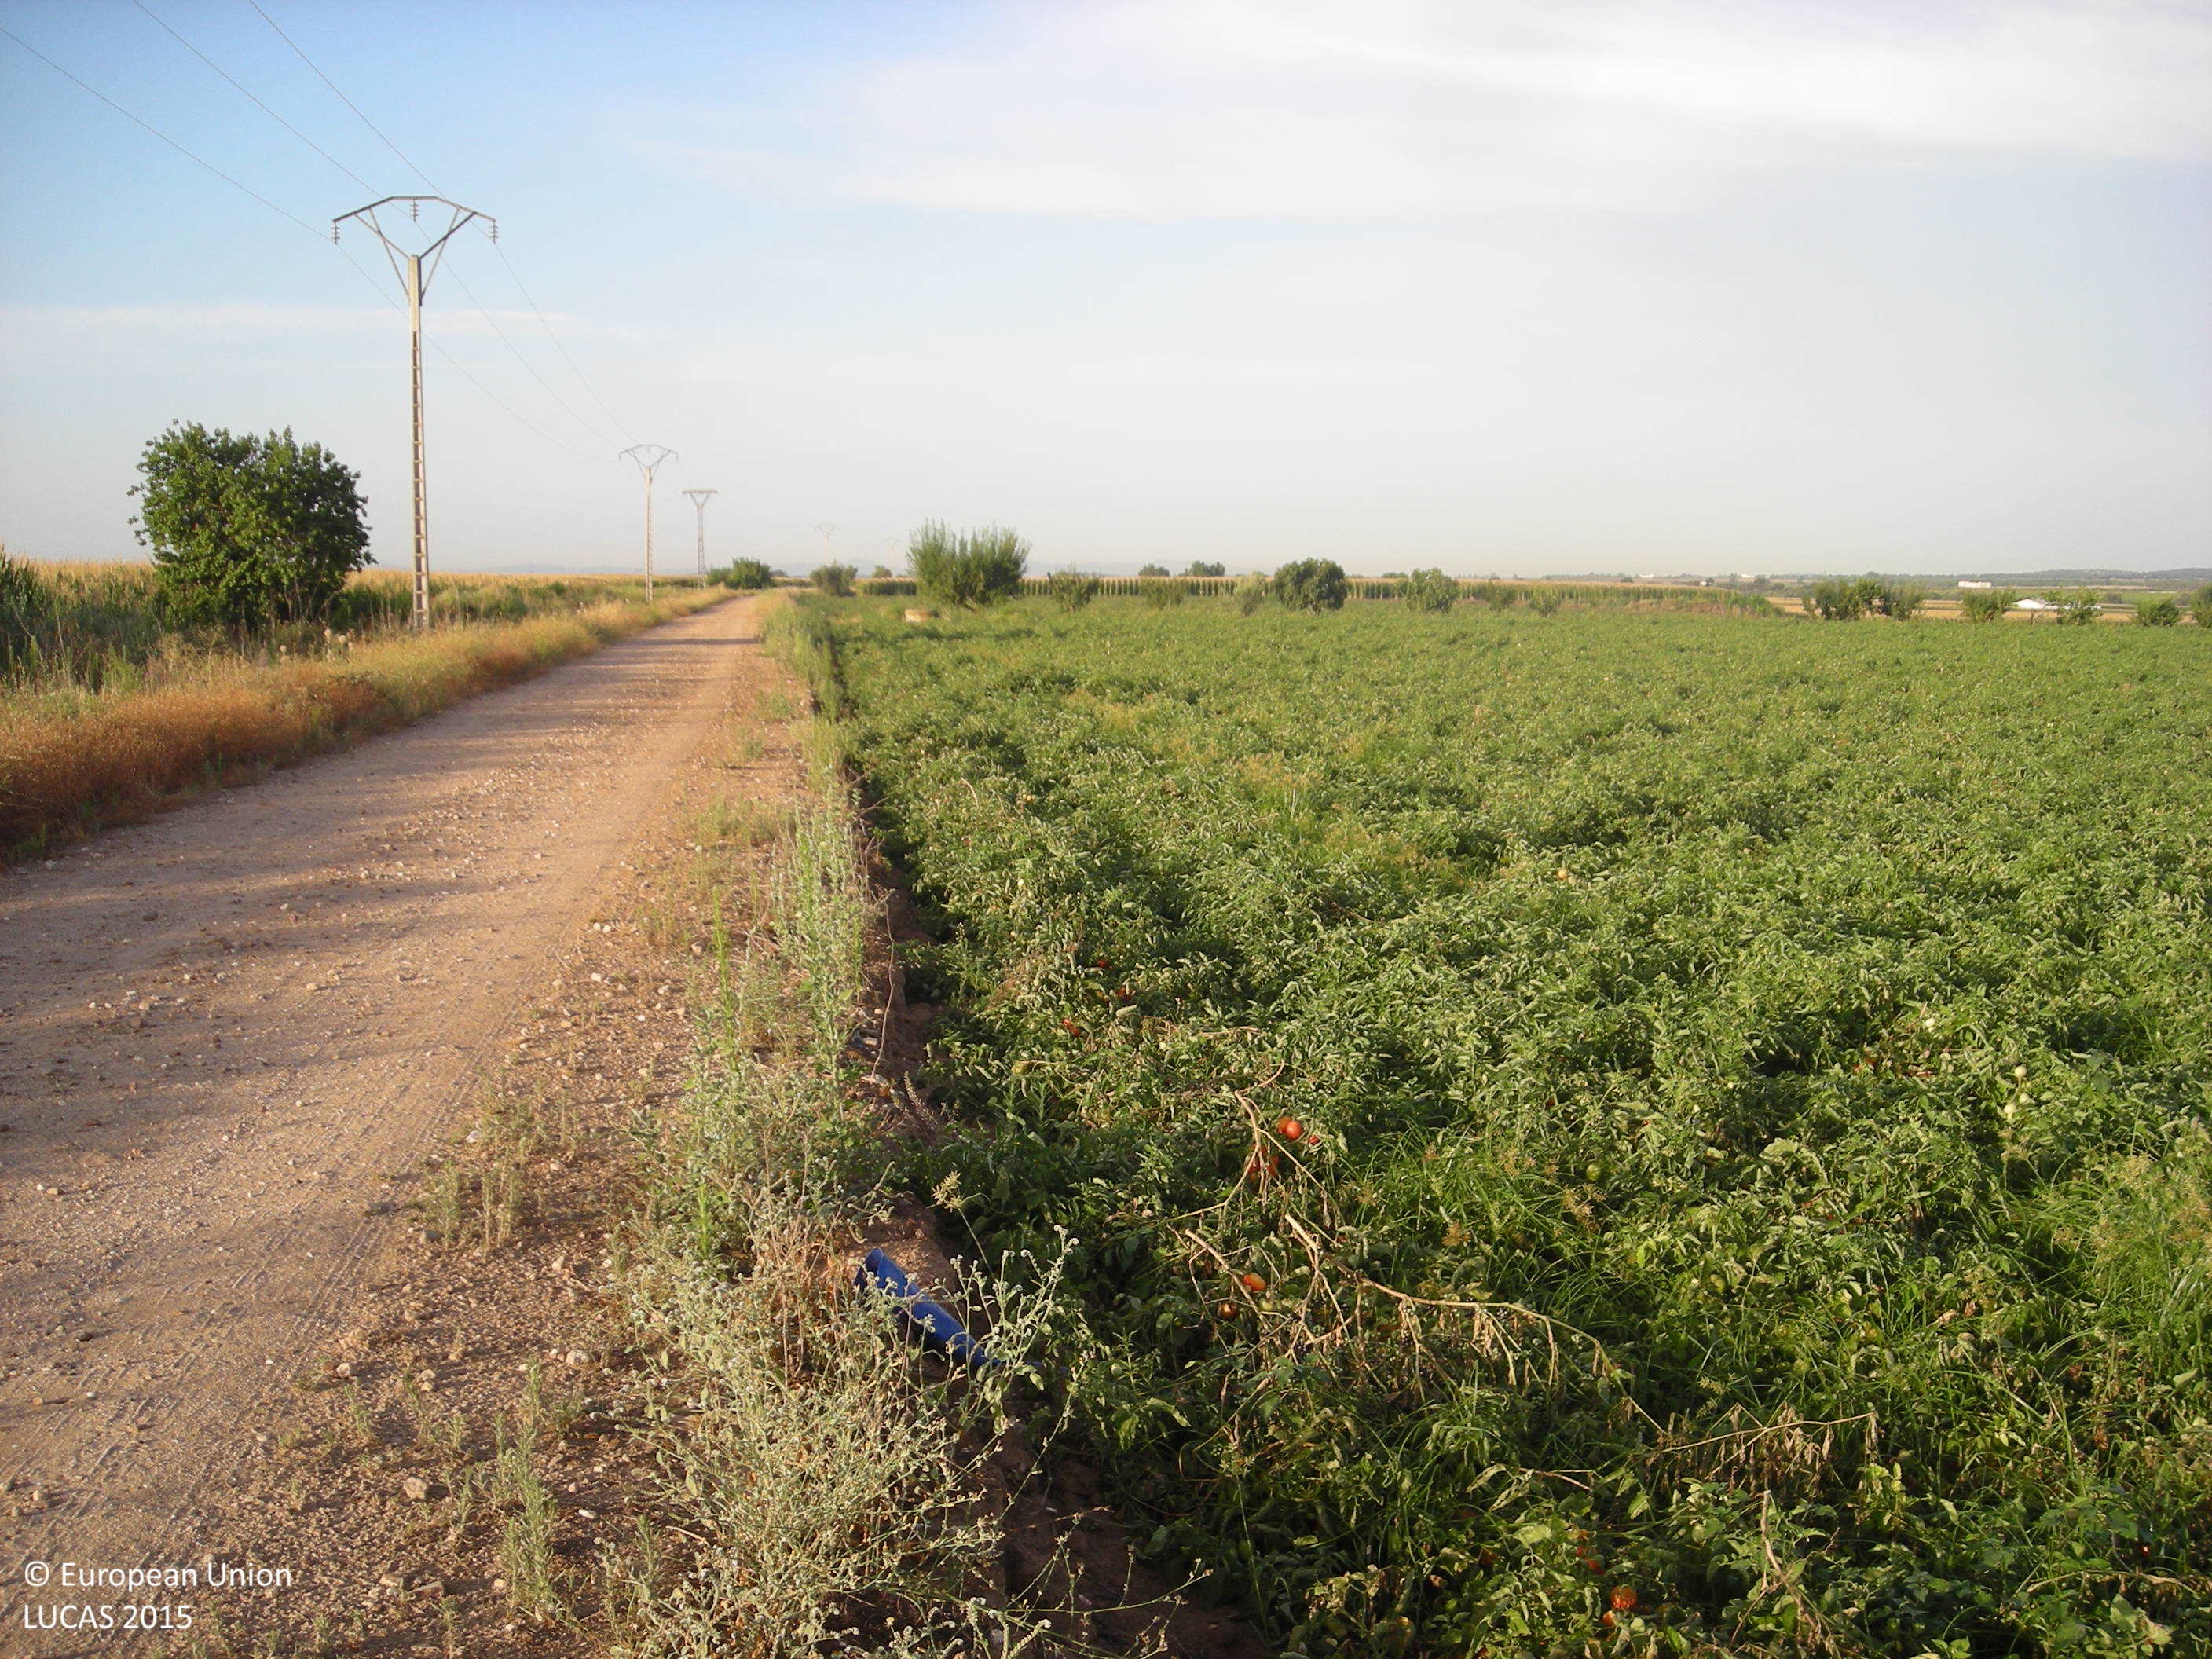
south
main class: Cropland
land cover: Tomatoes
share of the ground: > 75 %
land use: Agriculture (excluding fallow land and kitchen gardens)
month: July
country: ES
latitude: 39.1276
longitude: -6.0065
